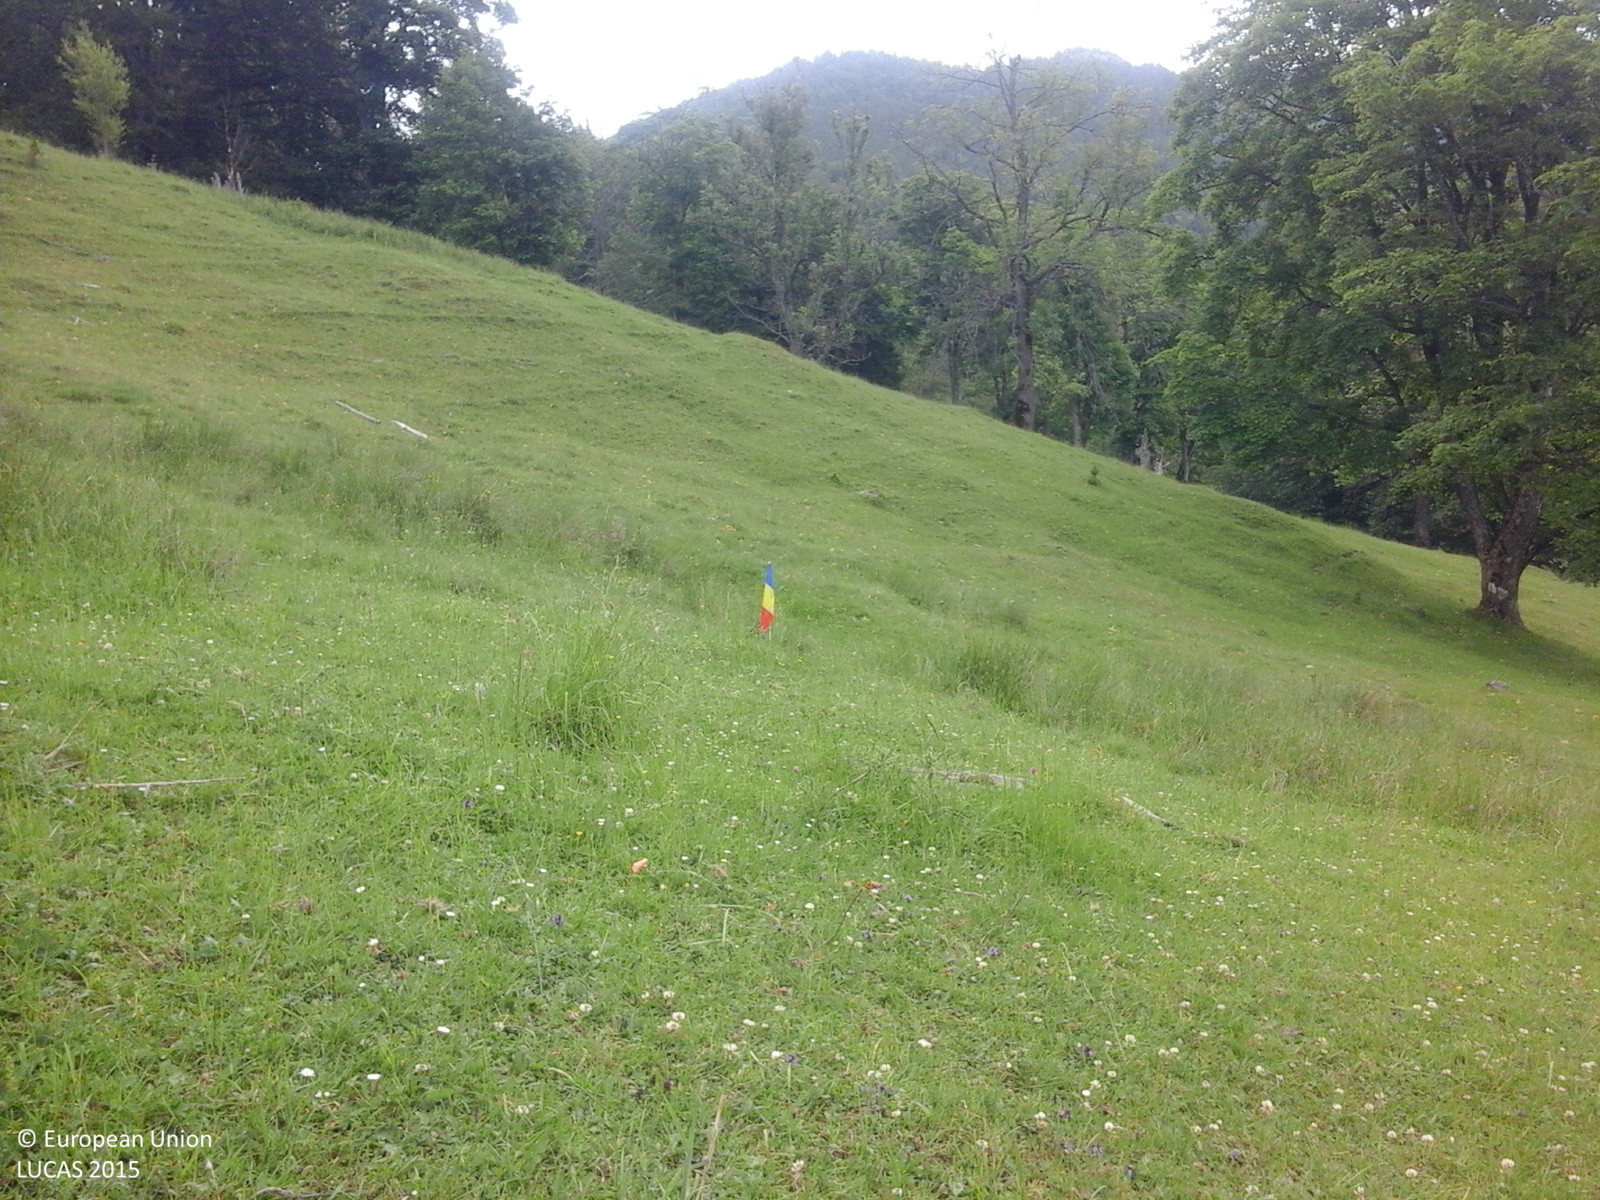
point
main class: Grassland
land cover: Grassland without tree/shrub cover
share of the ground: > 75 %
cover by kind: herbaceous plants 100 %
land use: Agriculture (excluding fallow land and kitchen gardens)
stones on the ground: 10 - 25 %
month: June
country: RO
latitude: 47.3323
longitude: 25.6681
